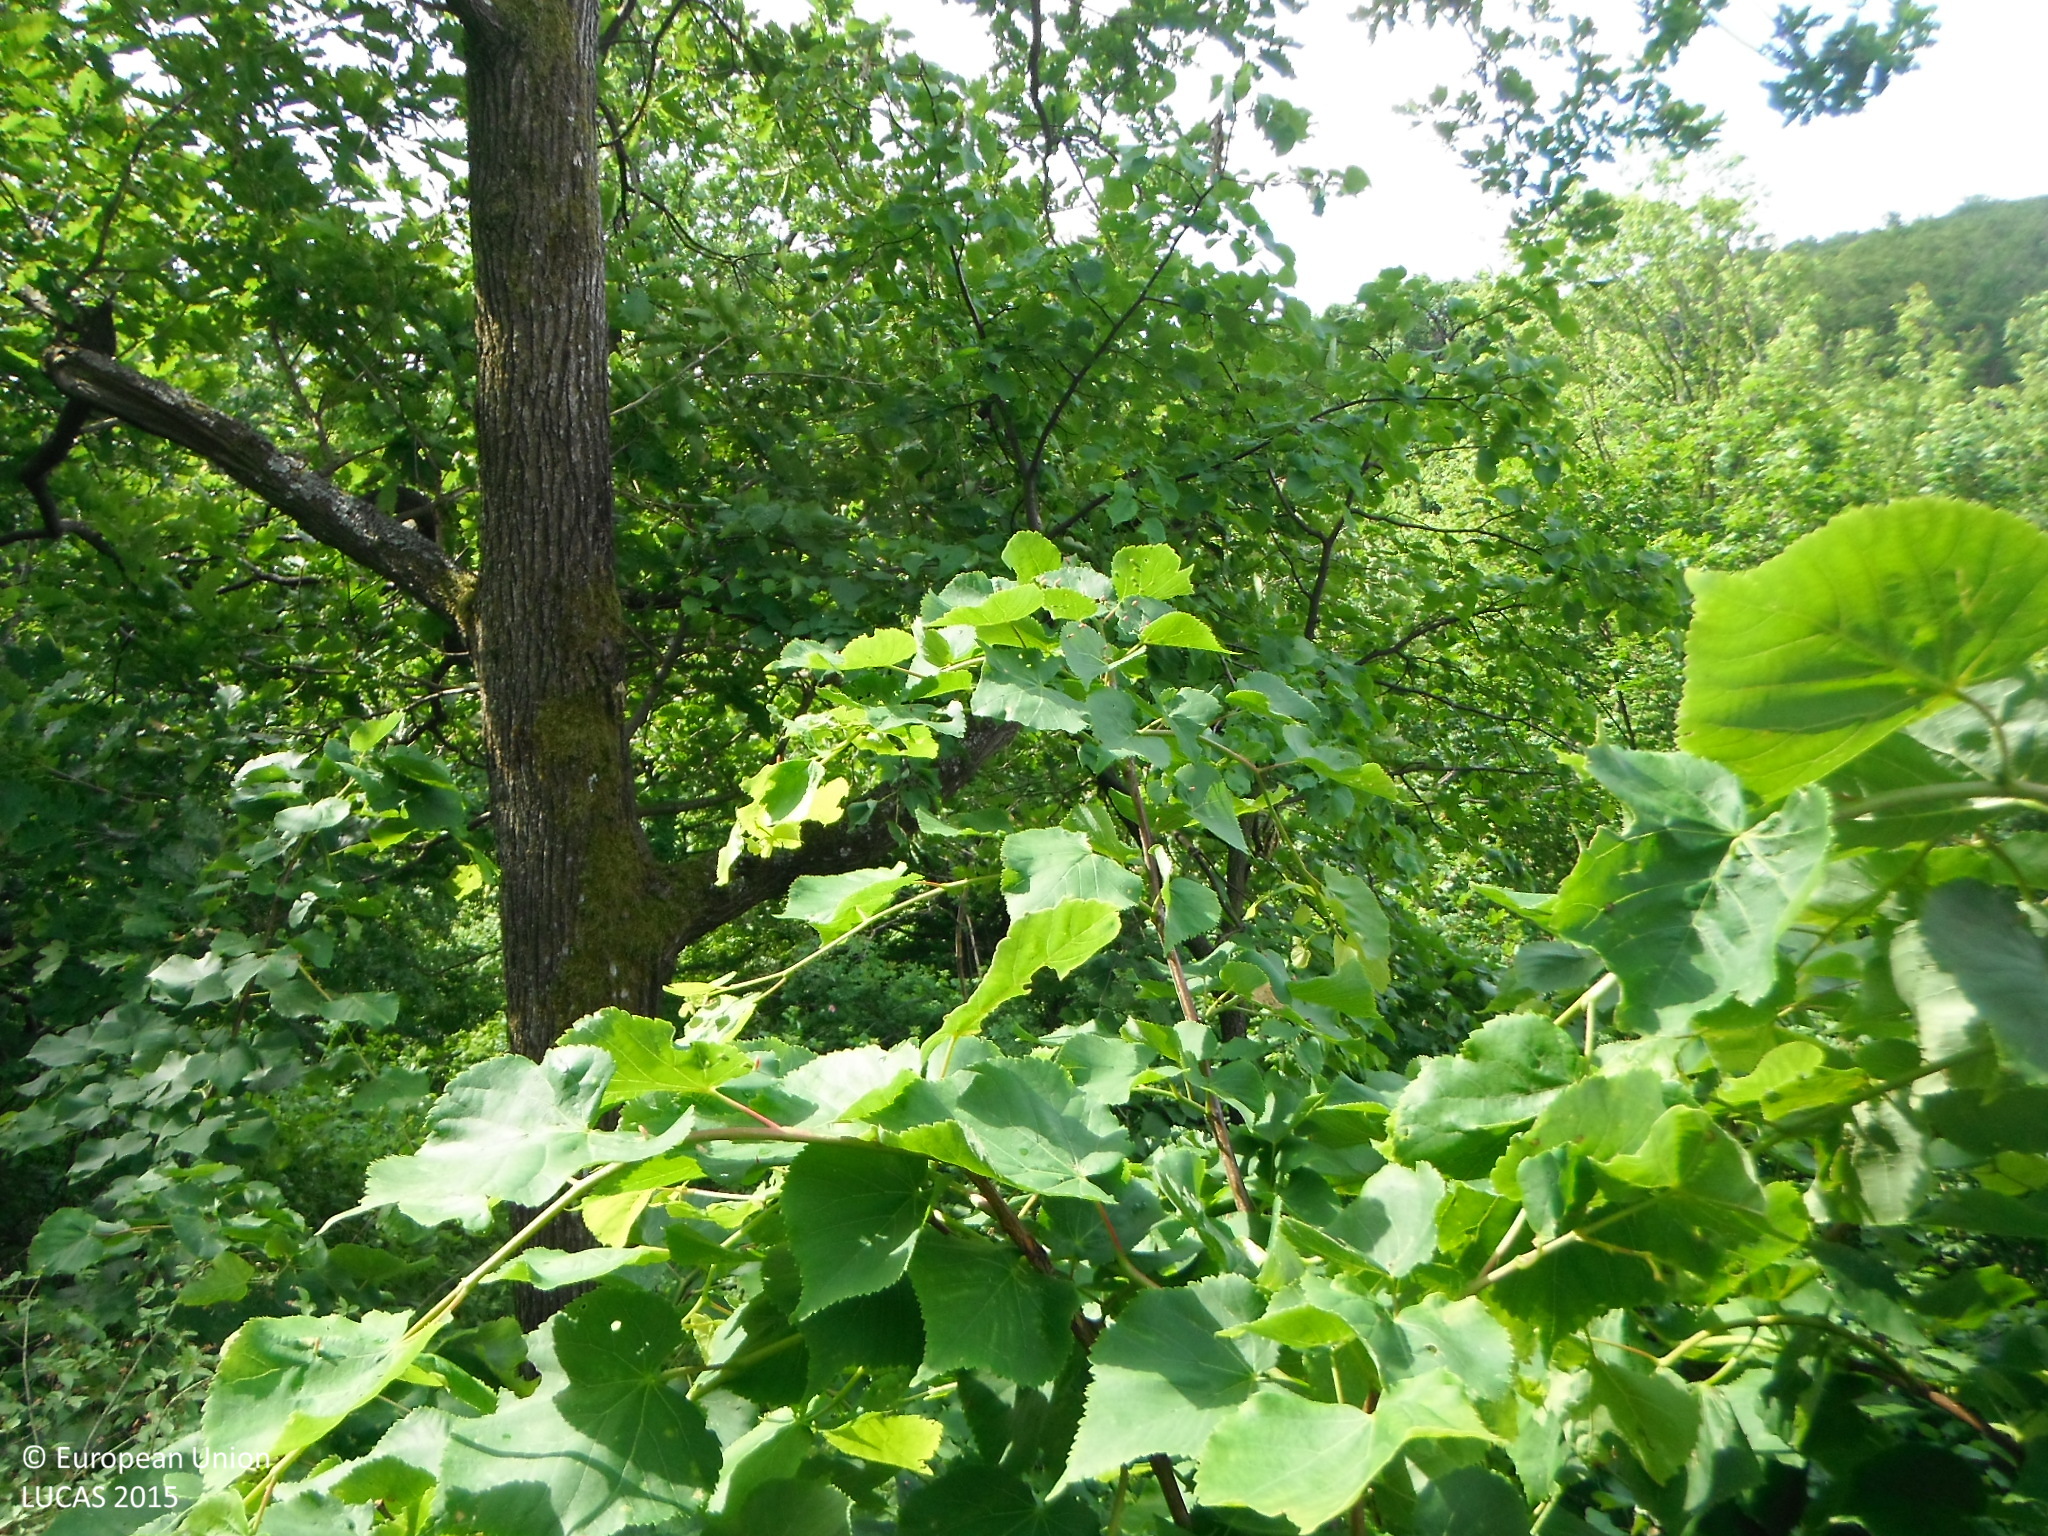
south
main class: Woodland
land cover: Broadleaved woodland
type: acidophilous oak and oak-birch forest
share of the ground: > 75 %
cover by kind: broadleaved forest trees 80 %, shrubs 10 %, herbaceous plants 10 %
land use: Forestry
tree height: > 5 m
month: May
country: SK
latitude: 48.2418
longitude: 17.1856
